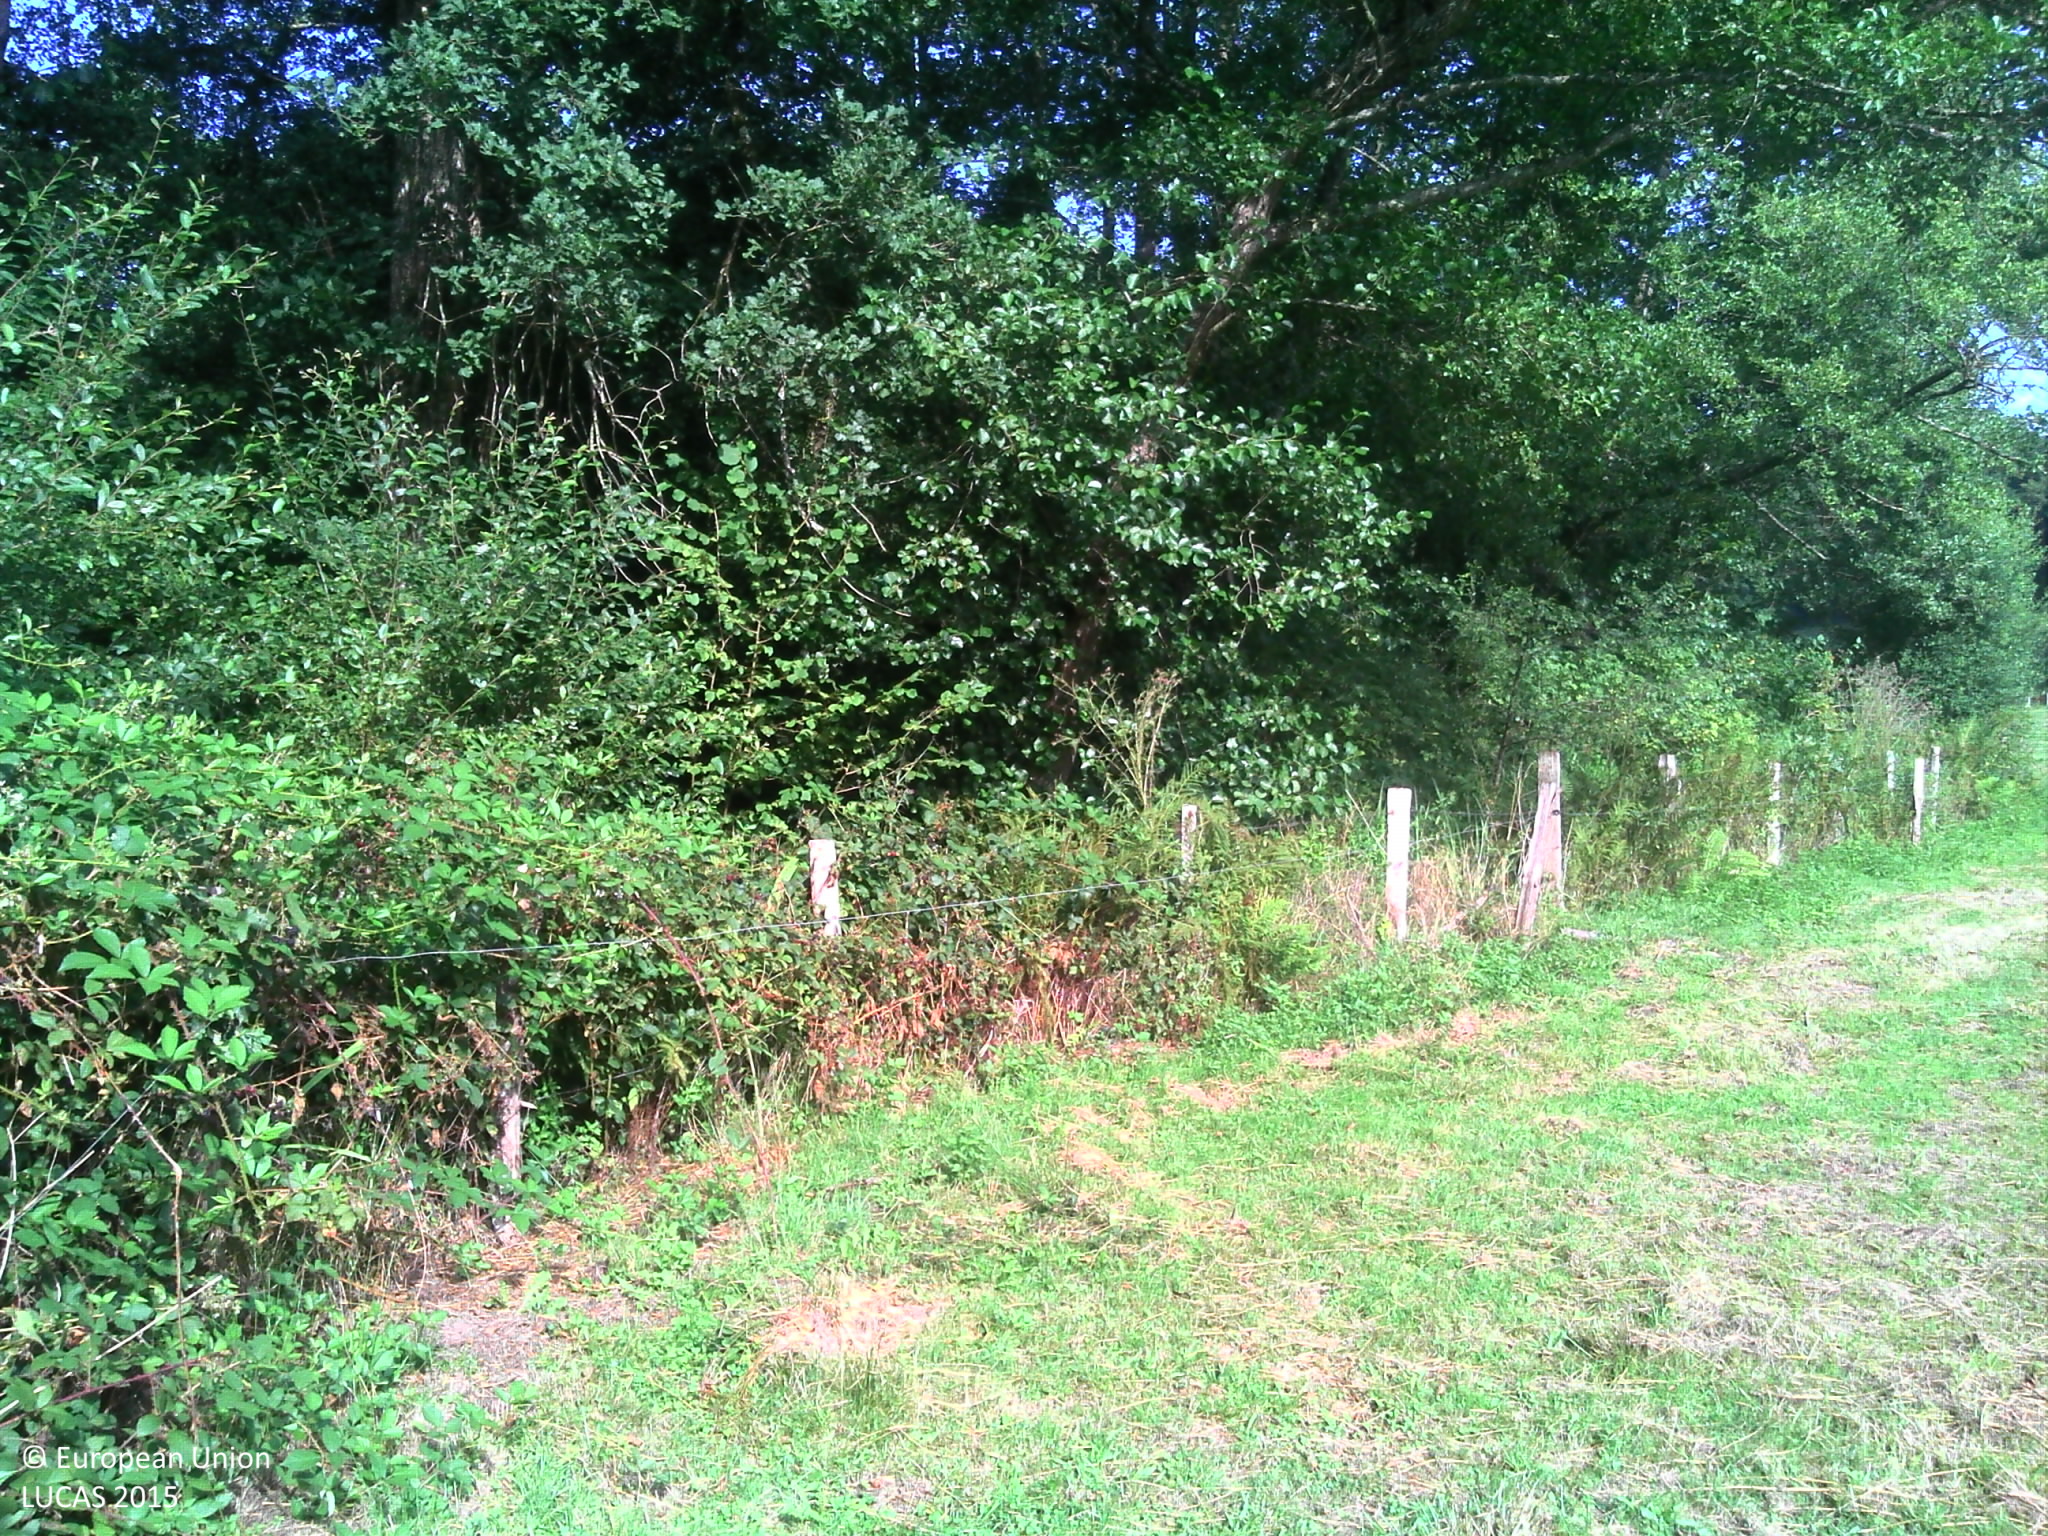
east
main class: Woodland
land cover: Broadleaved woodland
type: floodplain forest
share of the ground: > 75 %
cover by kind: broadleaved forest trees 70 %, shrubs 15 %, herbaceous plants 15 %
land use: Forestry
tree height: > 5 m
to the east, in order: Broadleaved woodland; Rivers and streams; Broadleaved woodland; Fences; Ditches and canals; Fences; Grassland without tree/shrub cover; Ditches and canals; Grassland without tree/shrub cover; Ditches and canals; Grassland without tree/shrub cover; Lines of trees; Tracks; Fences; Broadleaved woodland; Rock outcrops; Broadleaved woodland; Ditches and canals; Grass margins; Paved roads, cycling and walking lanes; Grass margins; Ditches and canals; Broadleaved woodland
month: August
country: FR
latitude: 46.1782
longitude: 1.7666
